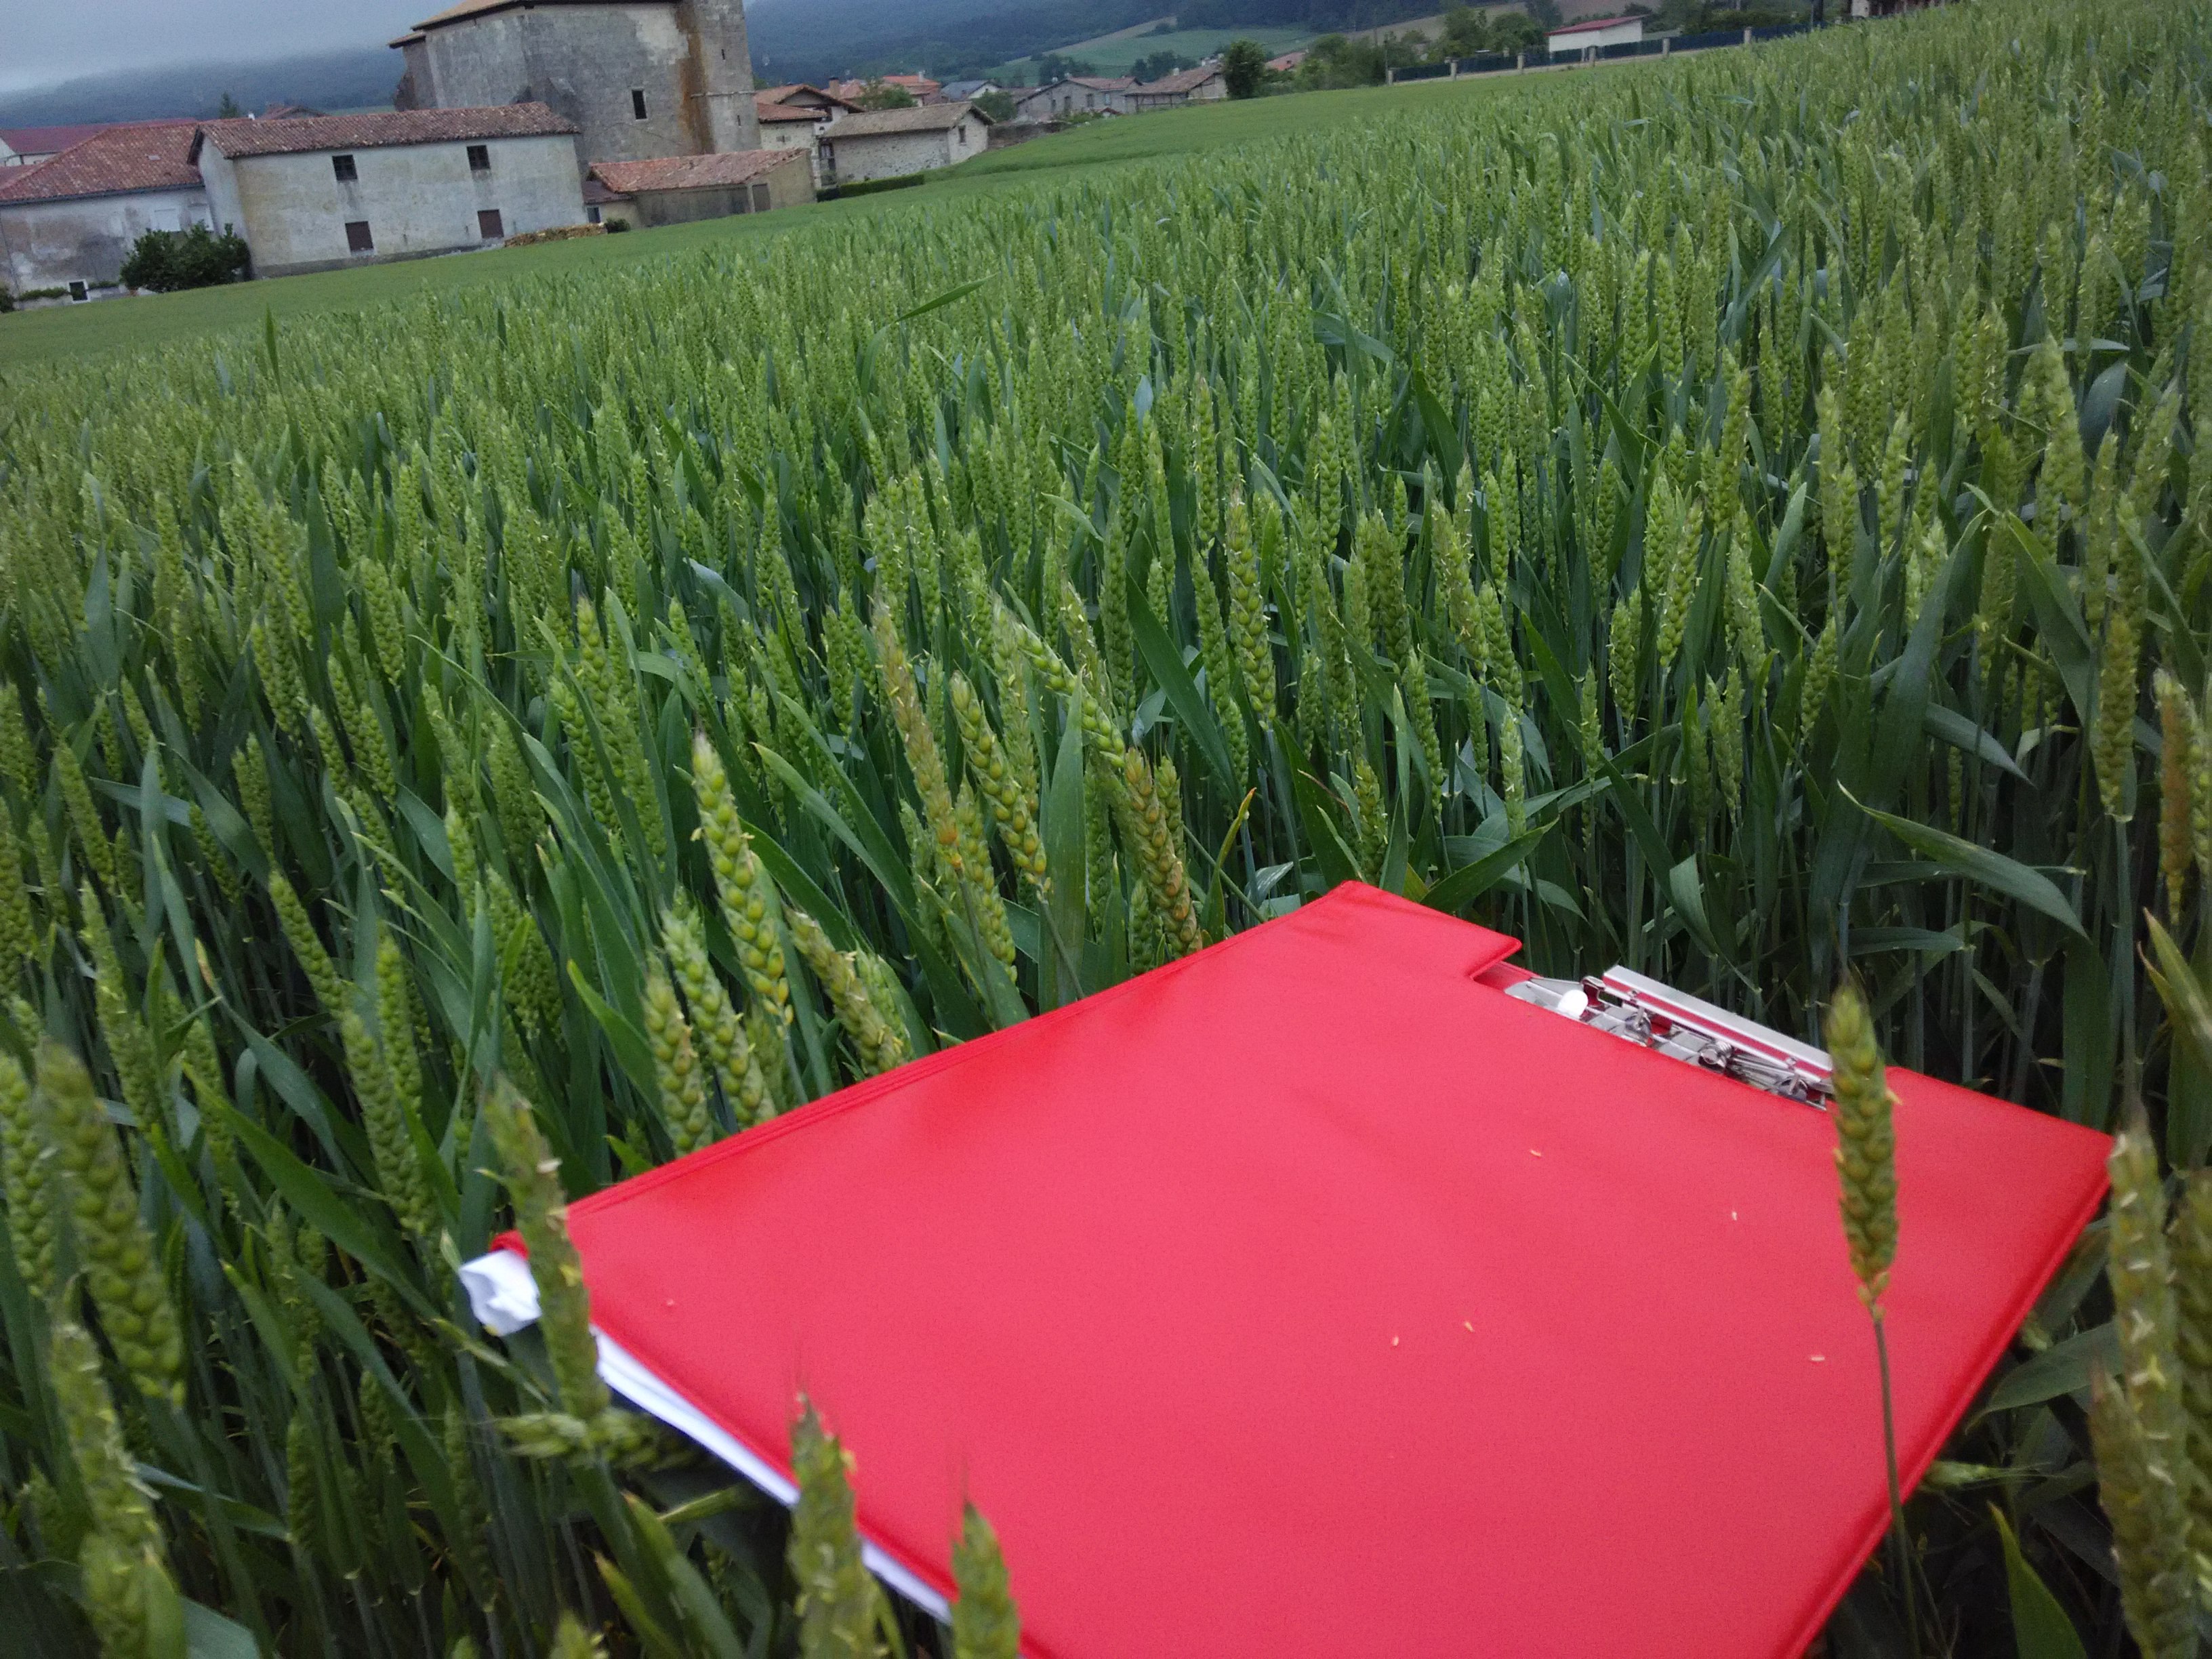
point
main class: Cropland
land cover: Common wheat
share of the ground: > 75 %
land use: Agriculture (excluding fallow land and kitchen gardens)
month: May
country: ES
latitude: 42.8119
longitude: -2.4612
